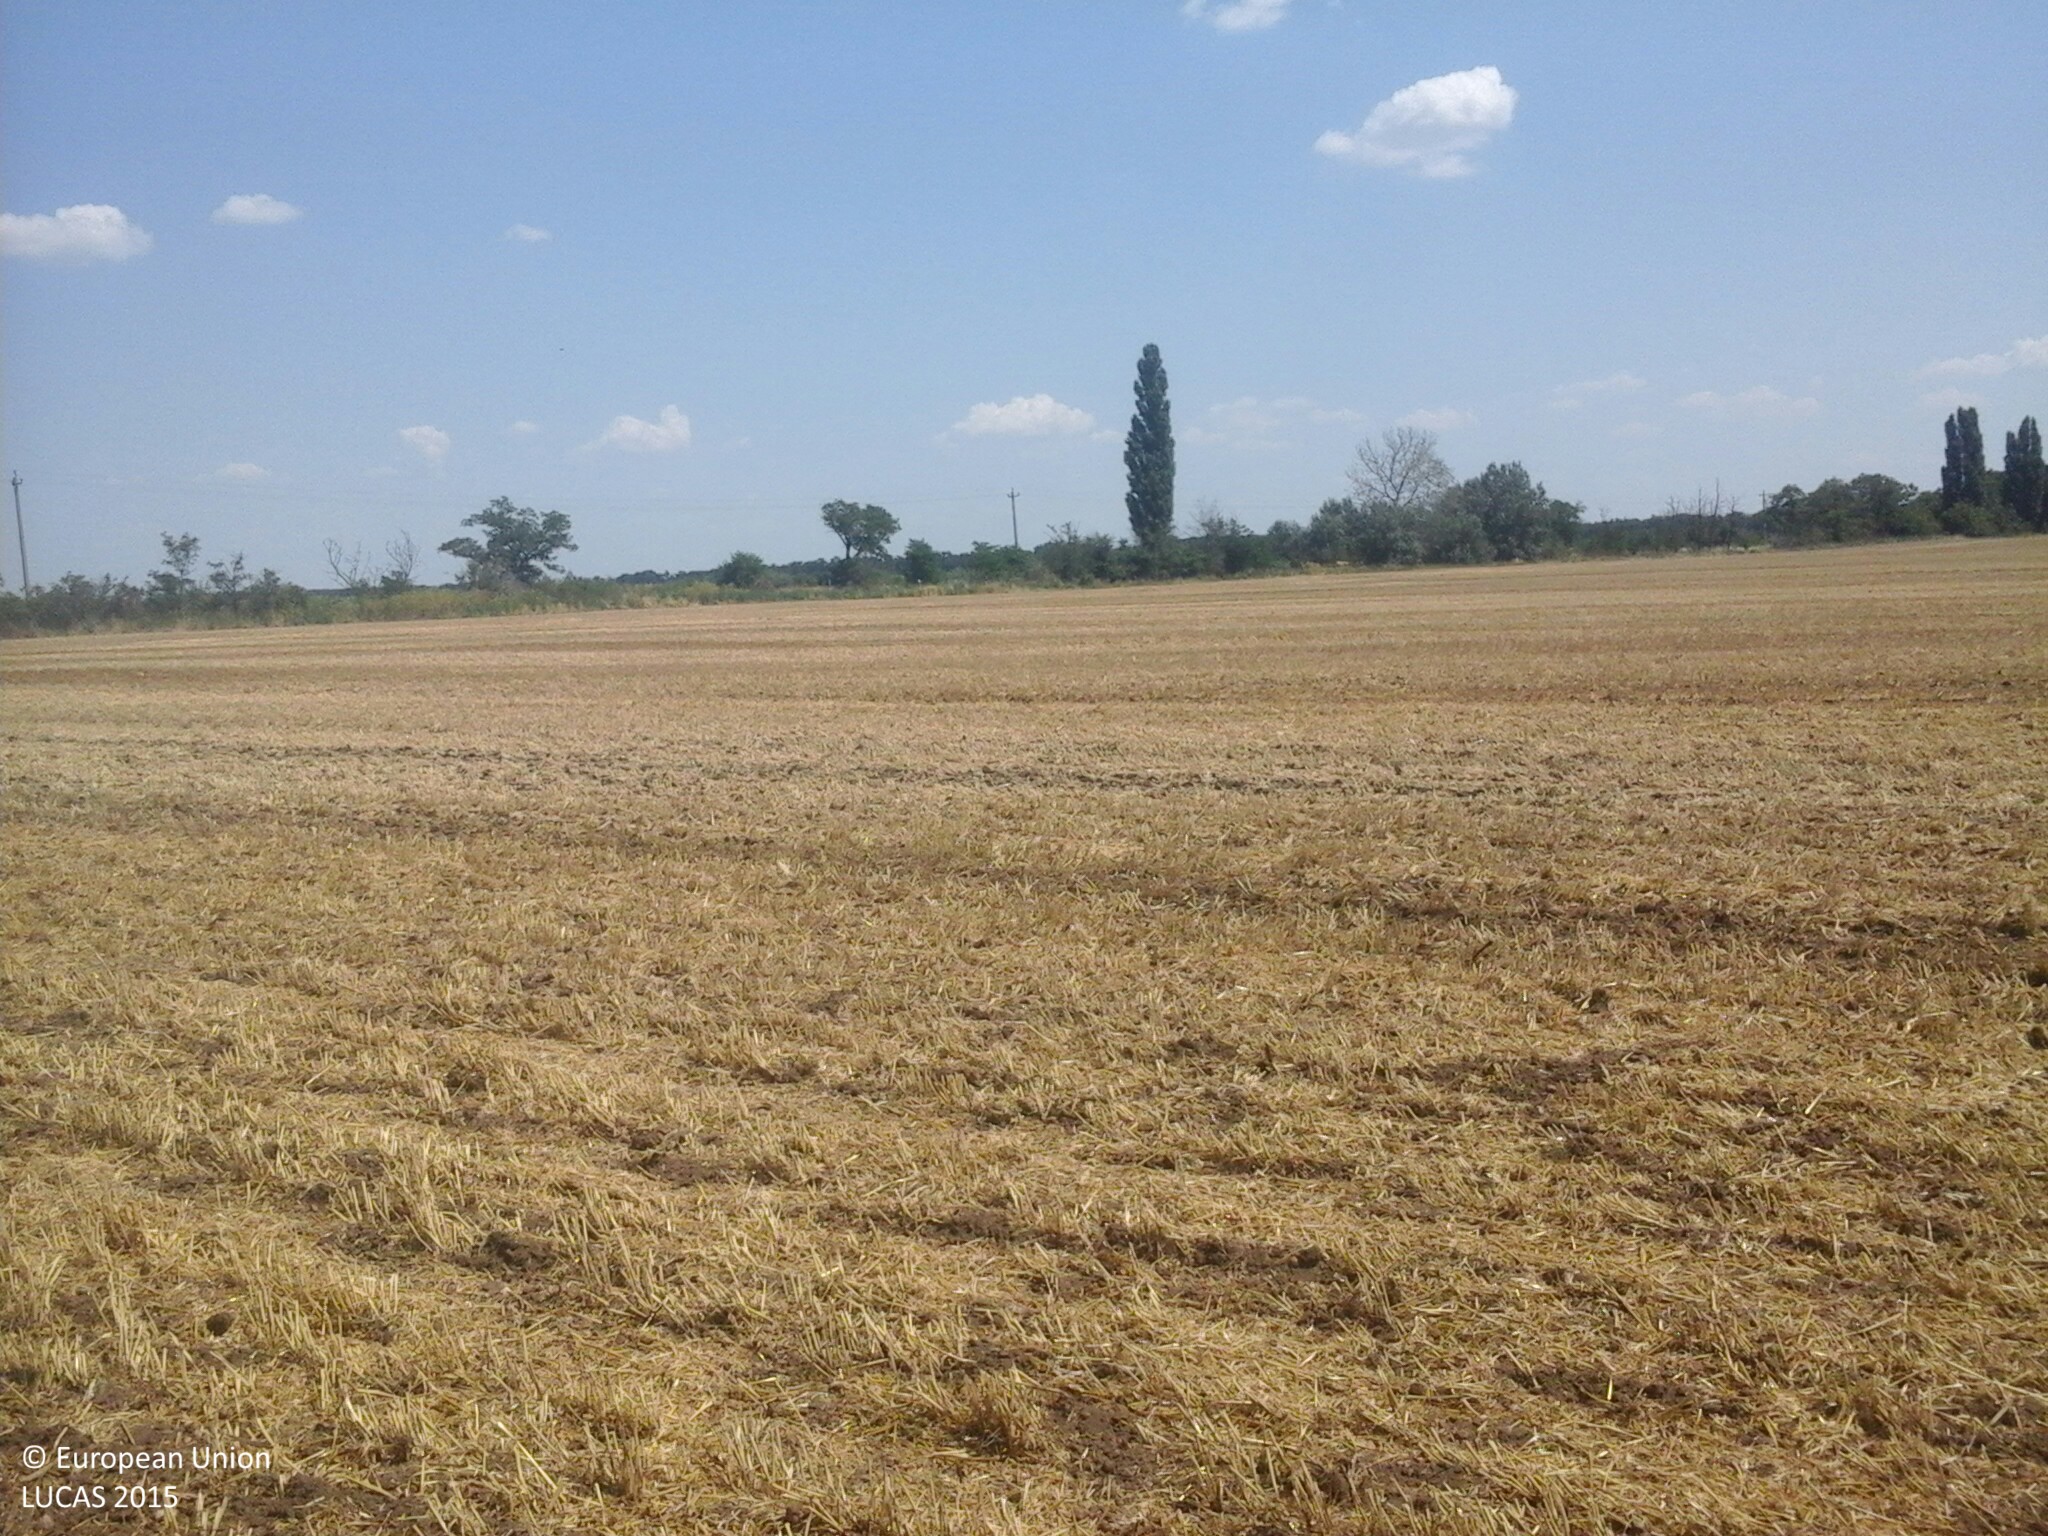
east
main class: Cropland
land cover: Common wheat
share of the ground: < 10 %
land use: Agriculture (excluding fallow land and kitchen gardens)
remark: Harvested field
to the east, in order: Common wheat; Abandoned hedges; Ditches and canals; Paved roads, cycling and walking lanes; Ditches and canals; Abandoned hedges; Sunflower; Electric lines; Sunflower
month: July
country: HU
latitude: 47.1198
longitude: 18.4610
